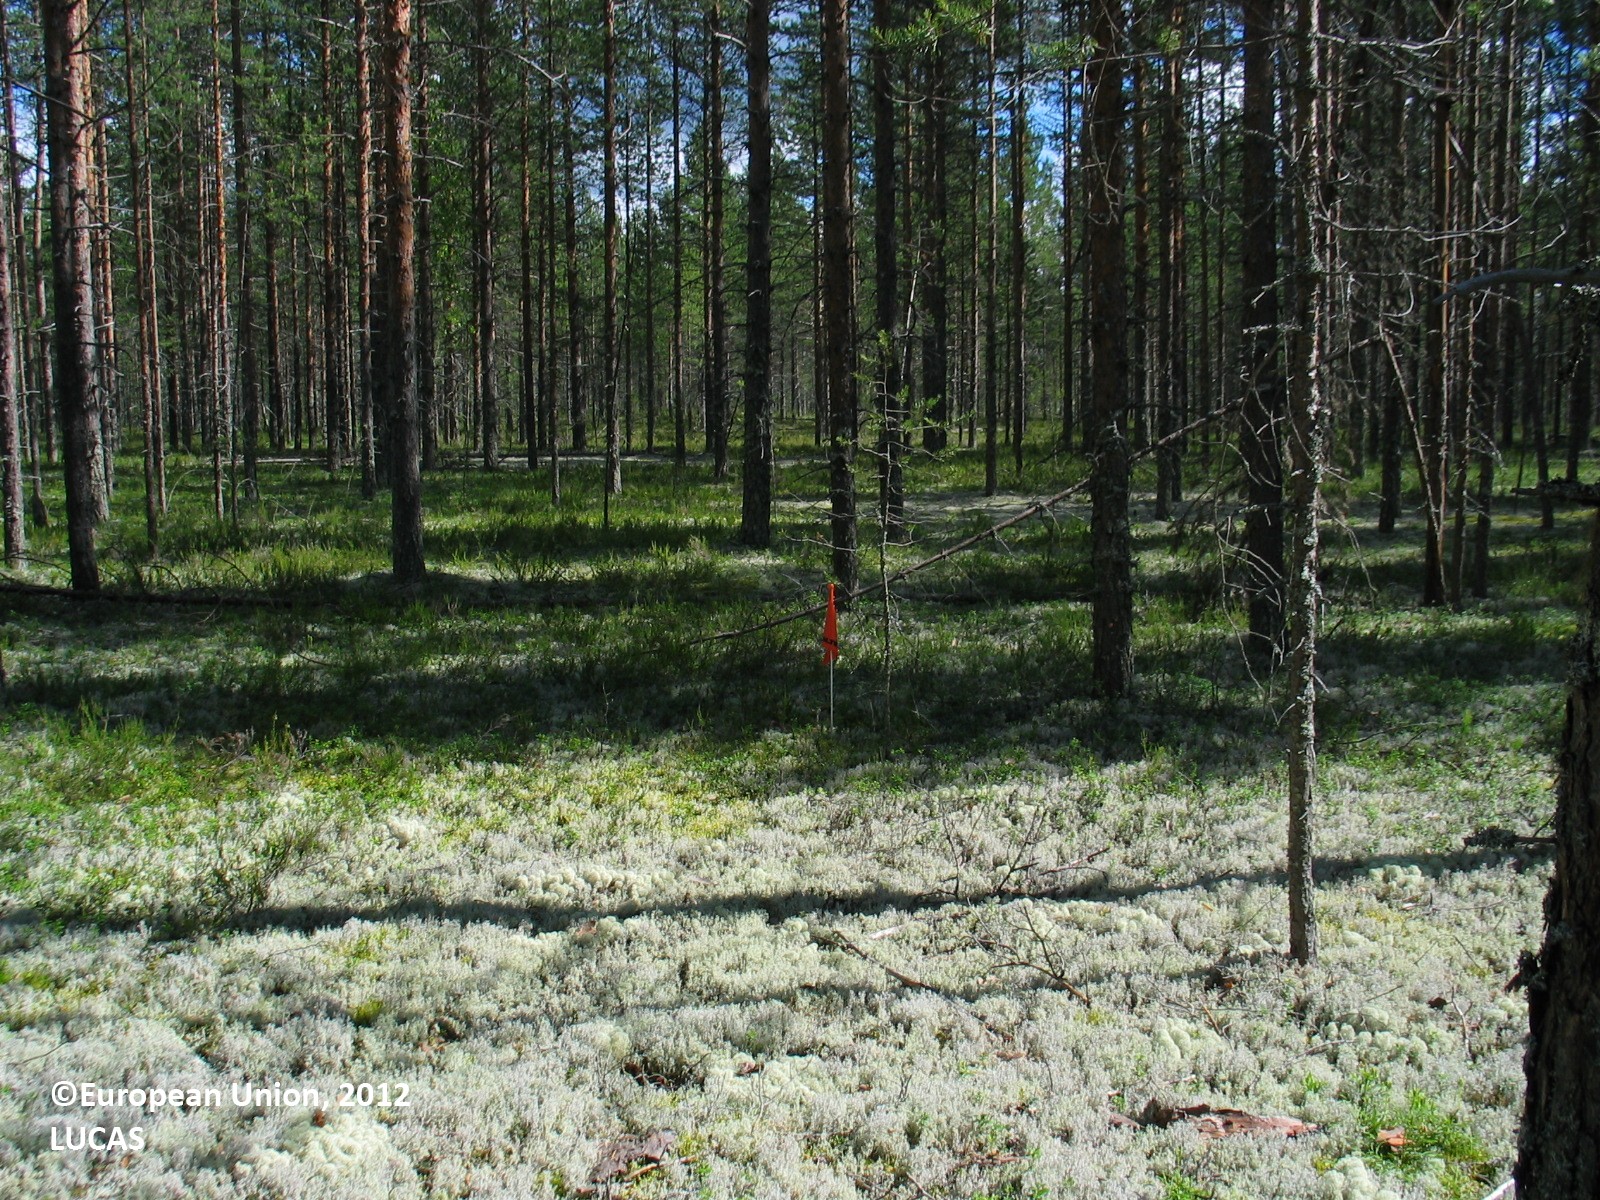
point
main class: Woodland
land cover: Pine dominated coniferous woodland
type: boreal forest
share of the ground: 25 - 50 %
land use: Amenities, museums, leisure
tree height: > 5 m
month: July
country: FI
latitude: 64.5860
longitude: 26.4648
